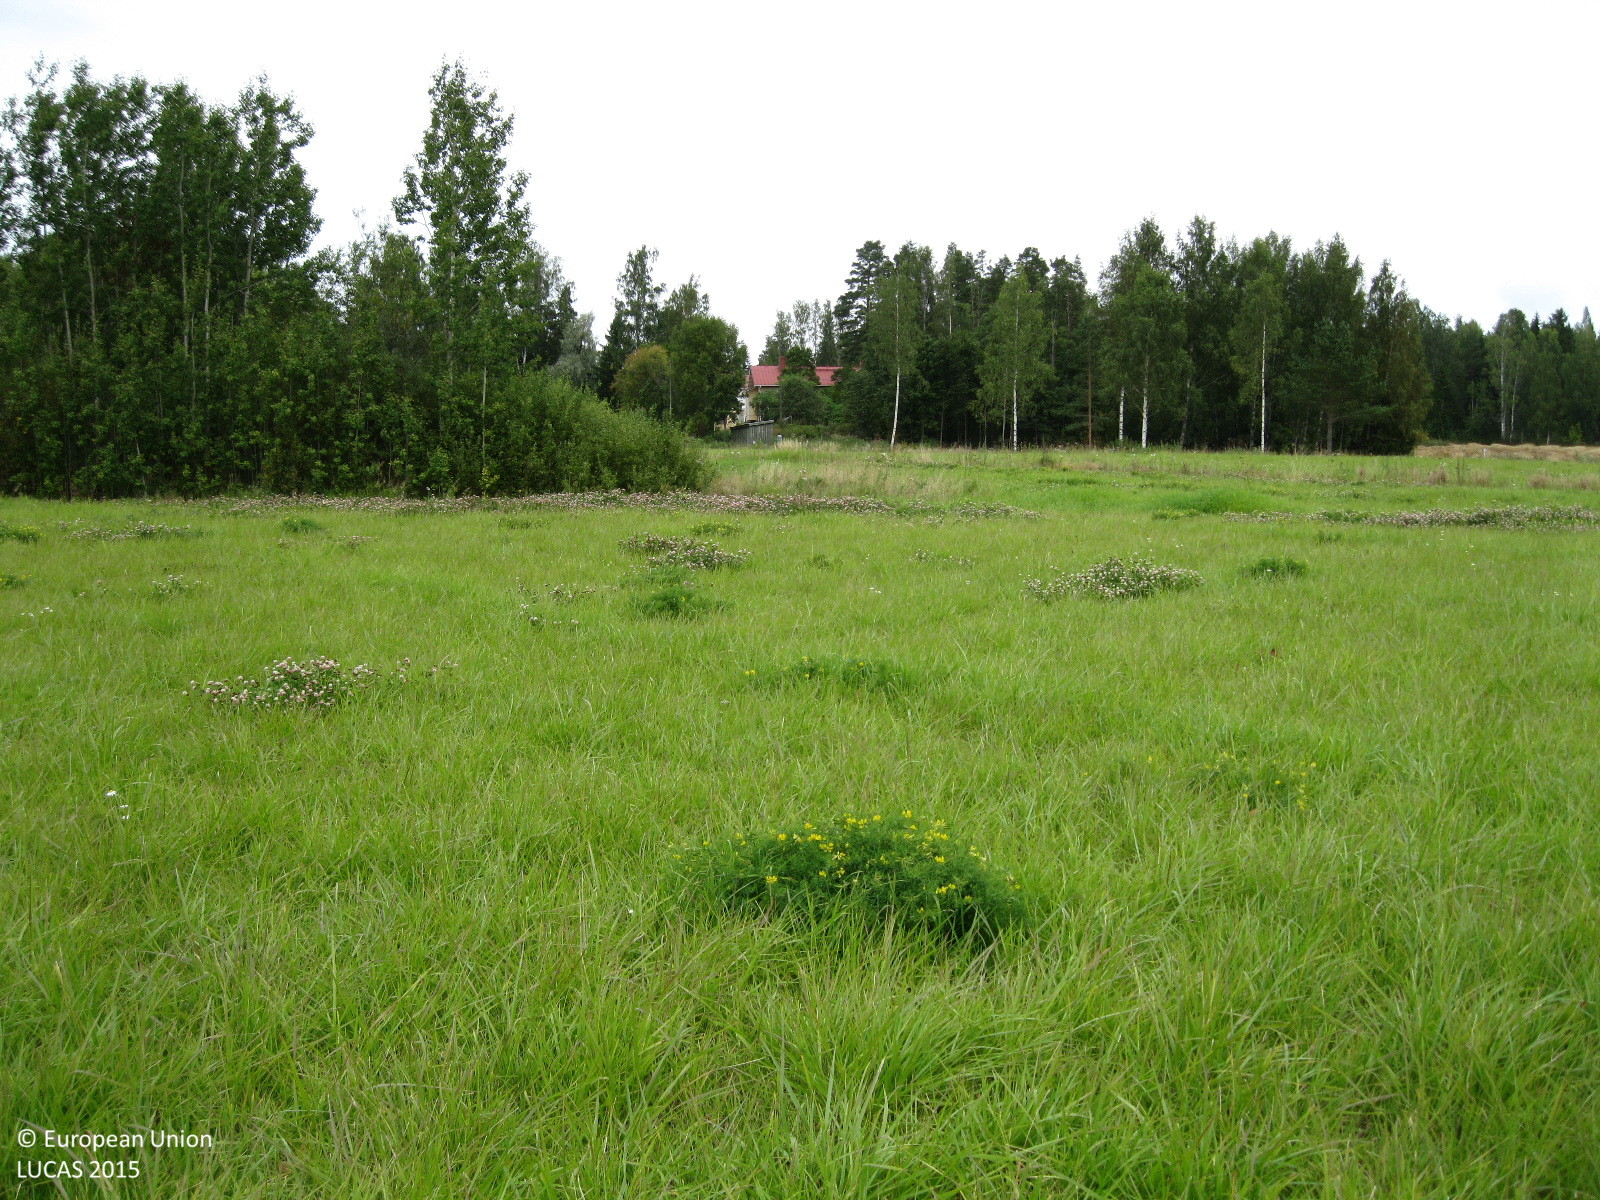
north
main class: Cropland
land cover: Temporary grasslands
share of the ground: > 75 %
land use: Agriculture (excluding fallow land and kitchen gardens)
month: September
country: FI
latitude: 60.4040
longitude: 24.7984
